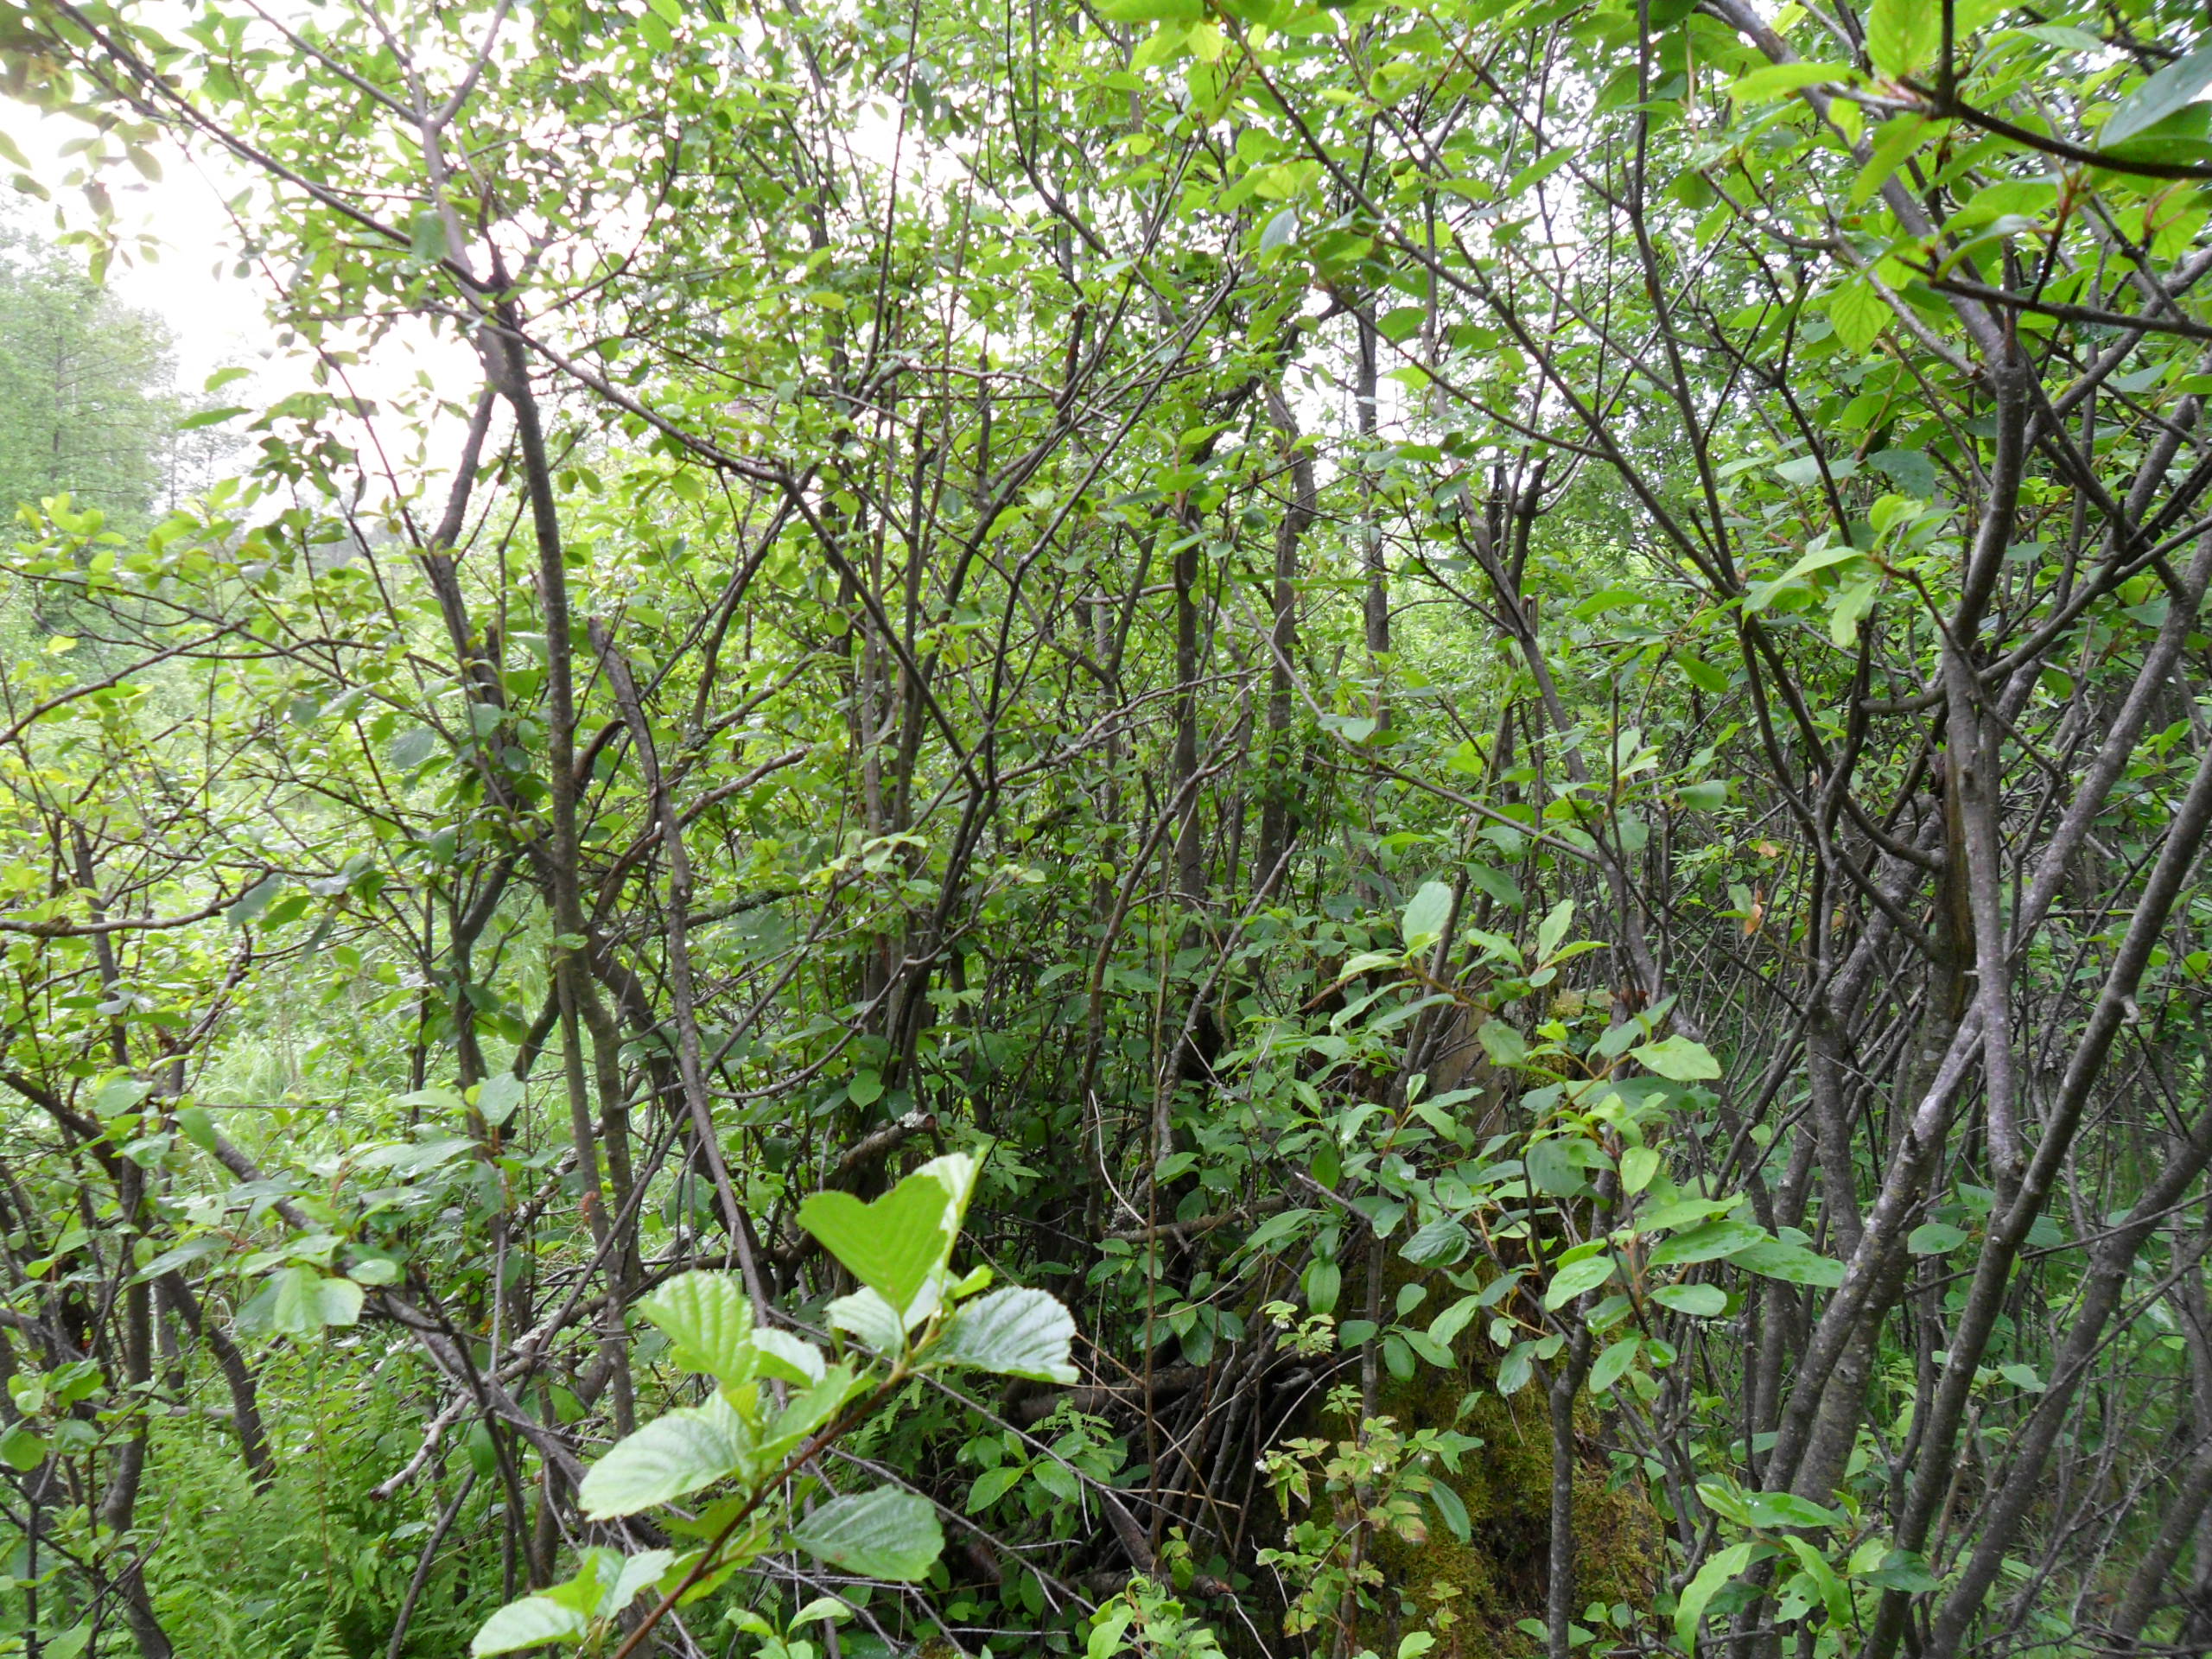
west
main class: Woodland
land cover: Broadleaved woodland
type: mire and swamp forests
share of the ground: 50 - 75 %
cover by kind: broadleaved forest trees 70 %, herbaceous plants 10 %
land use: Semi-natural and natural areas not in use
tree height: > 5 m
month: June
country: LV
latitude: 57.2132
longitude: 22.1186
